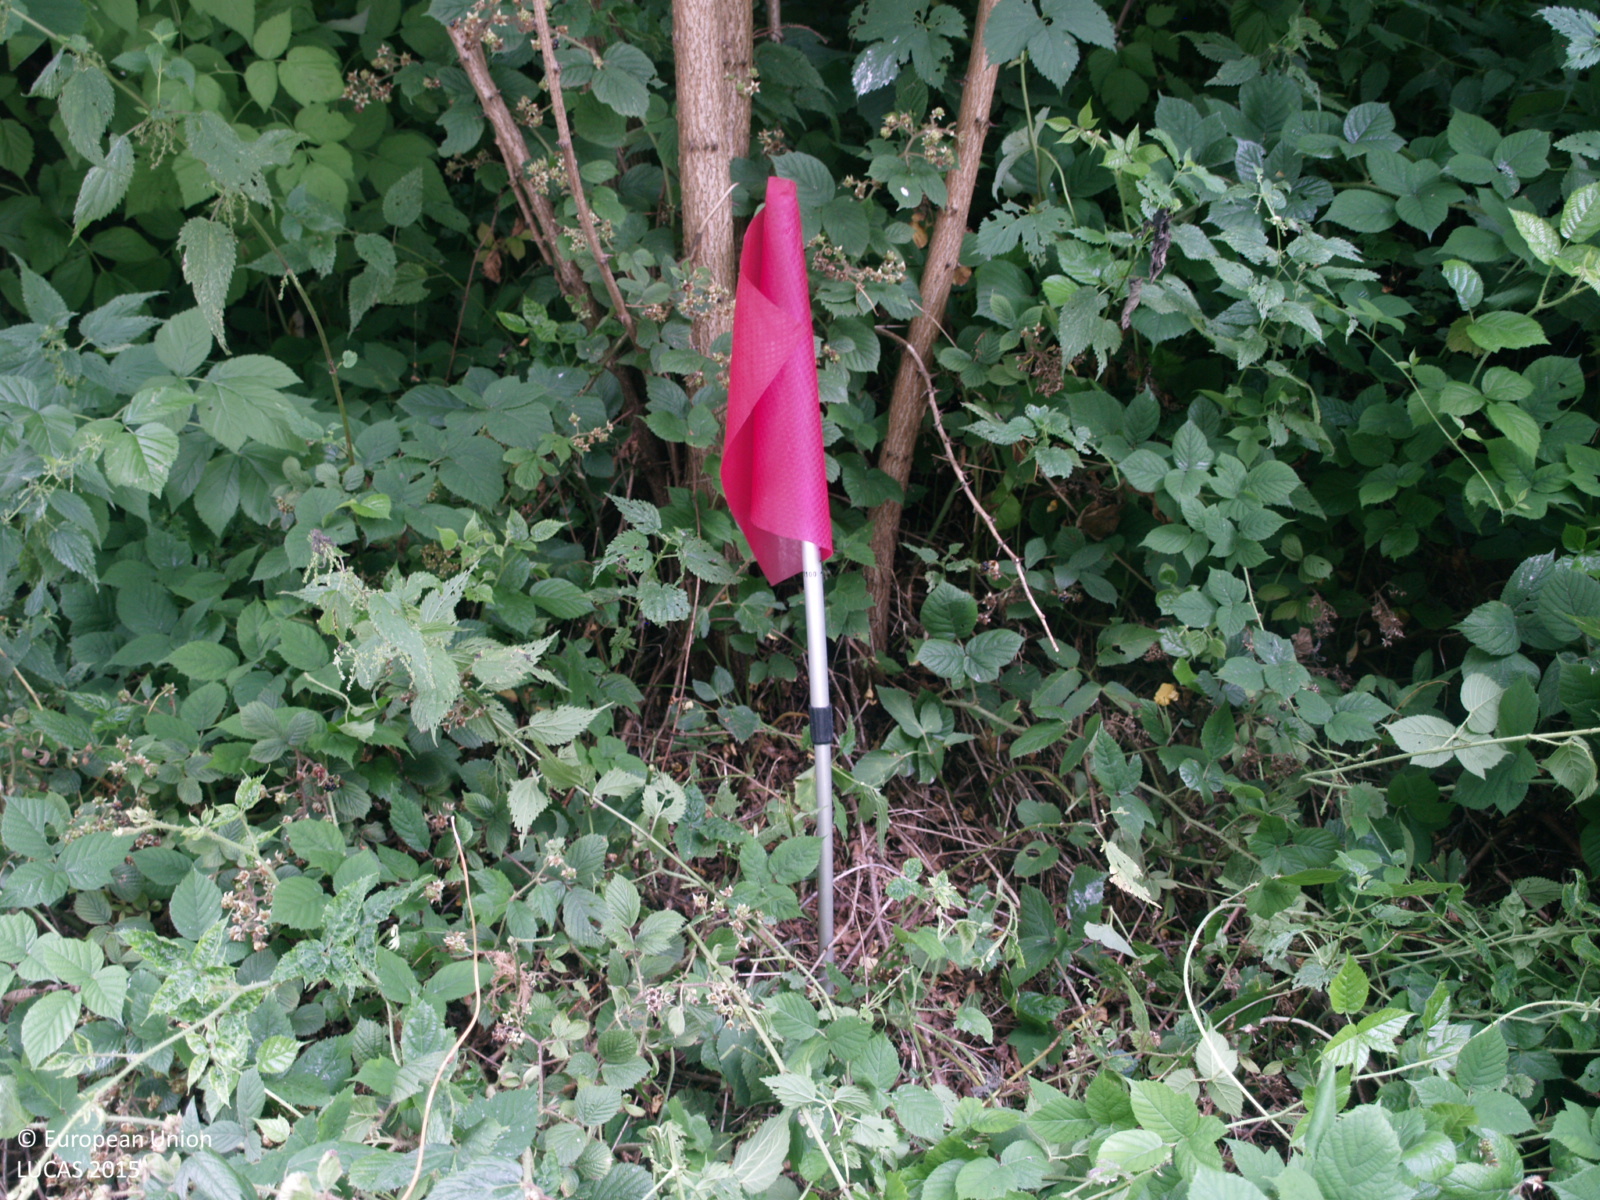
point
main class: Woodland
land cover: Broadleaved woodland
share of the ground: > 75 %
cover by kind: shrubs 60 %, broadleaved forest trees 40 %
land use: Semi-natural and natural areas not in use
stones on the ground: 10 - 25 %
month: May
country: IT
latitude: 45.8775
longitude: 11.0678
